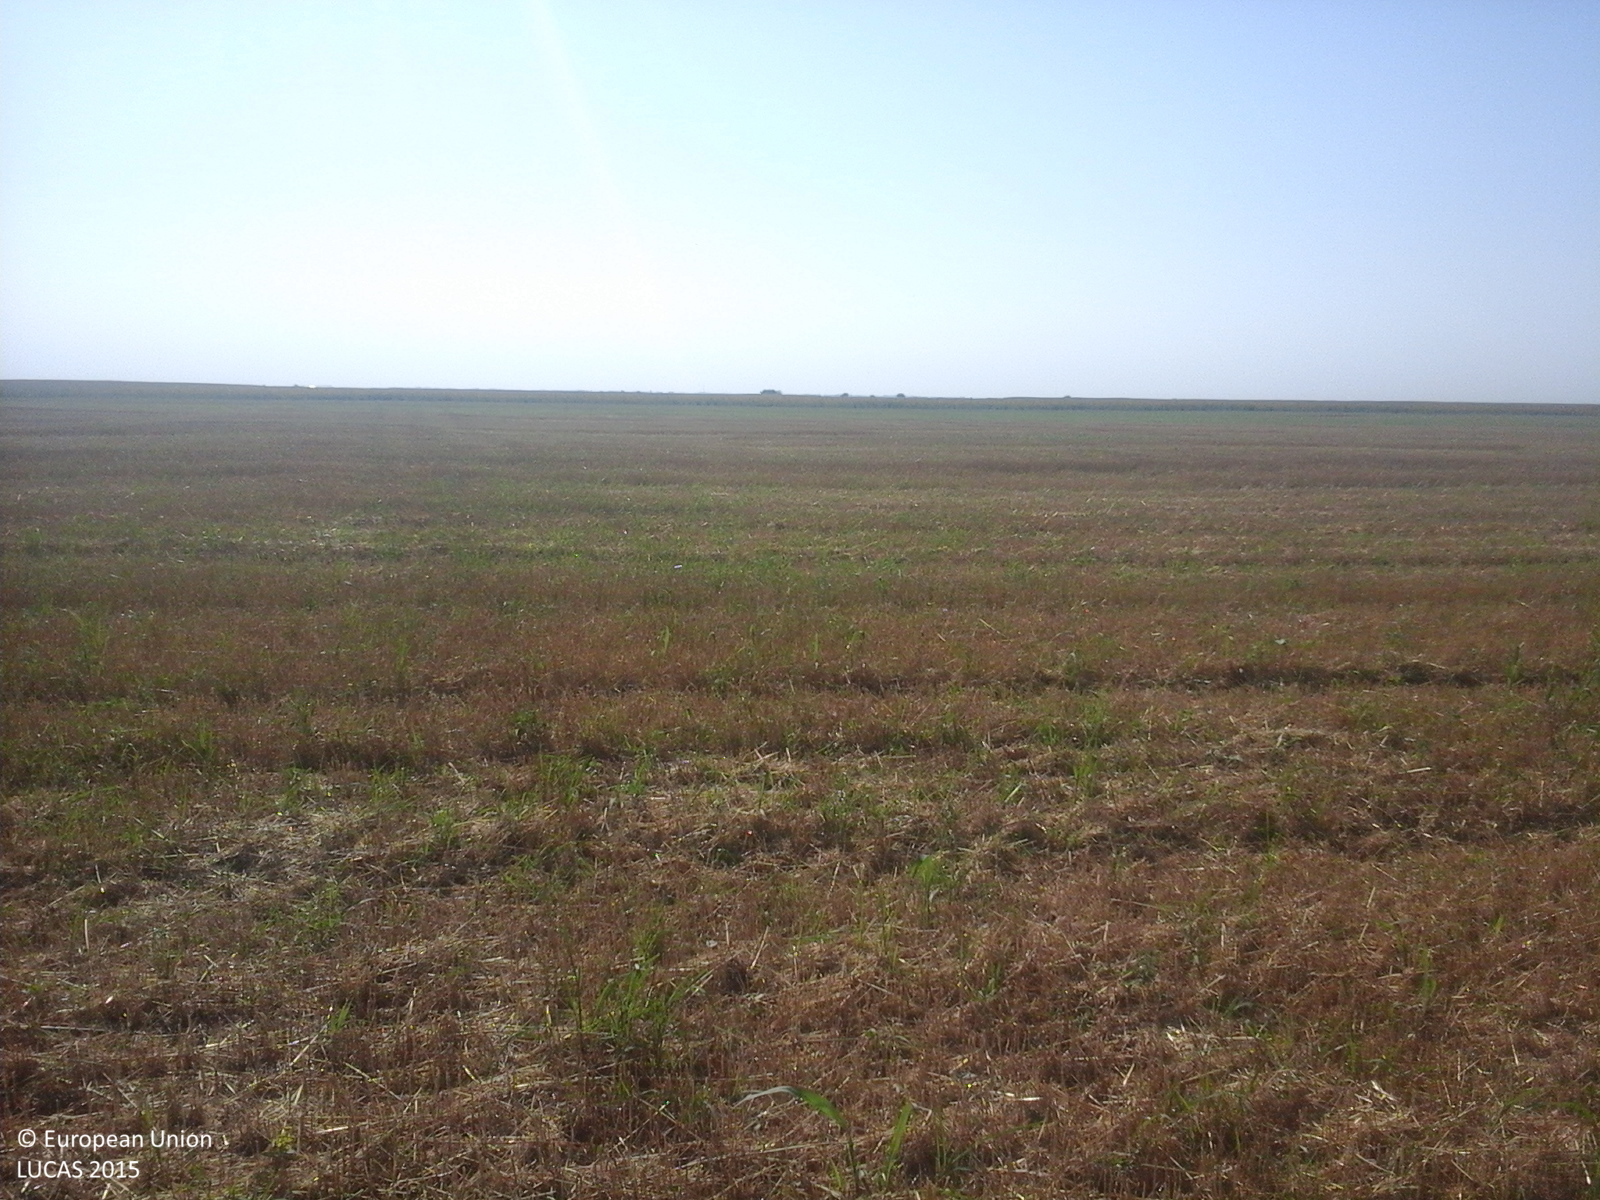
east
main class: Cropland
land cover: Common wheat
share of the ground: 10 - 25 %
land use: Agriculture (excluding fallow land and kitchen gardens)
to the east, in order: Common wheat; Sunflower
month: July
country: RO
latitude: 44.3500
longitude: 27.2323
